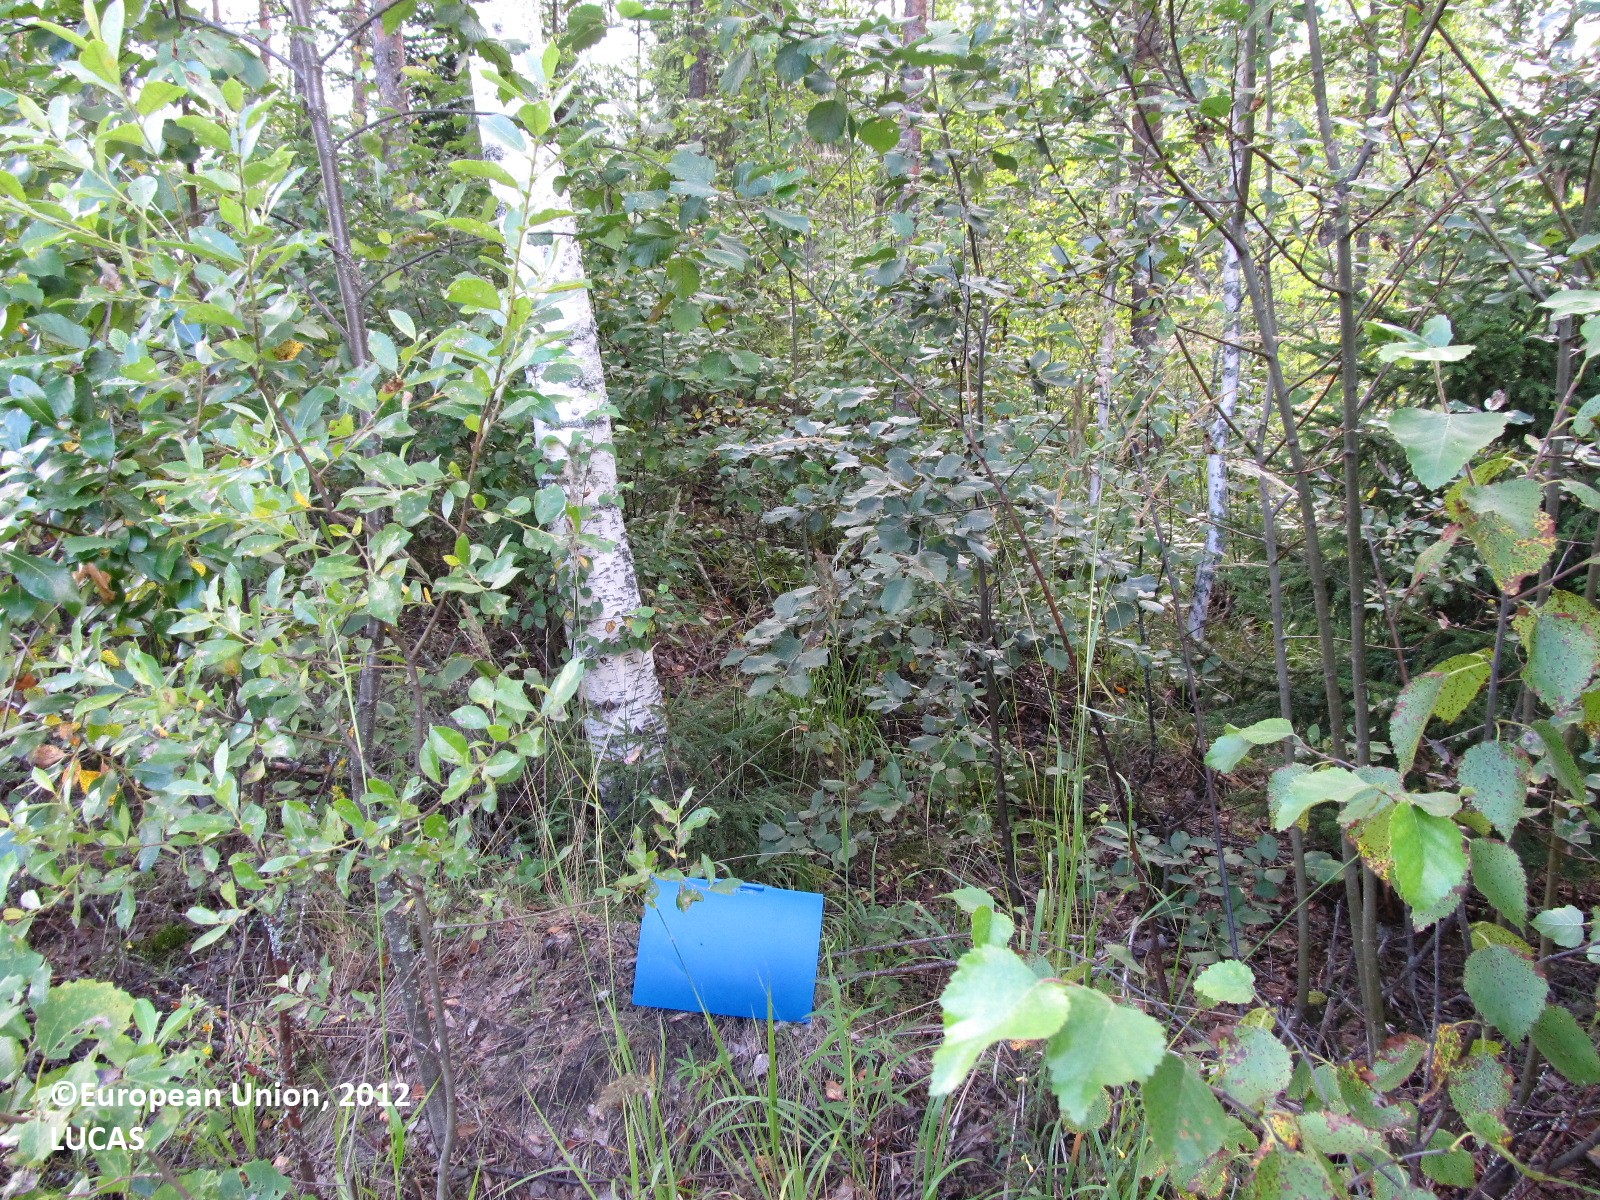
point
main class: Woodland
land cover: Pine dominated mixed woodland
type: boreal forest
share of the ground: 50 - 75 %
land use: Forestry
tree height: > 5 m
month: August
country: FI
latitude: 62.3108
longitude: 28.3103
